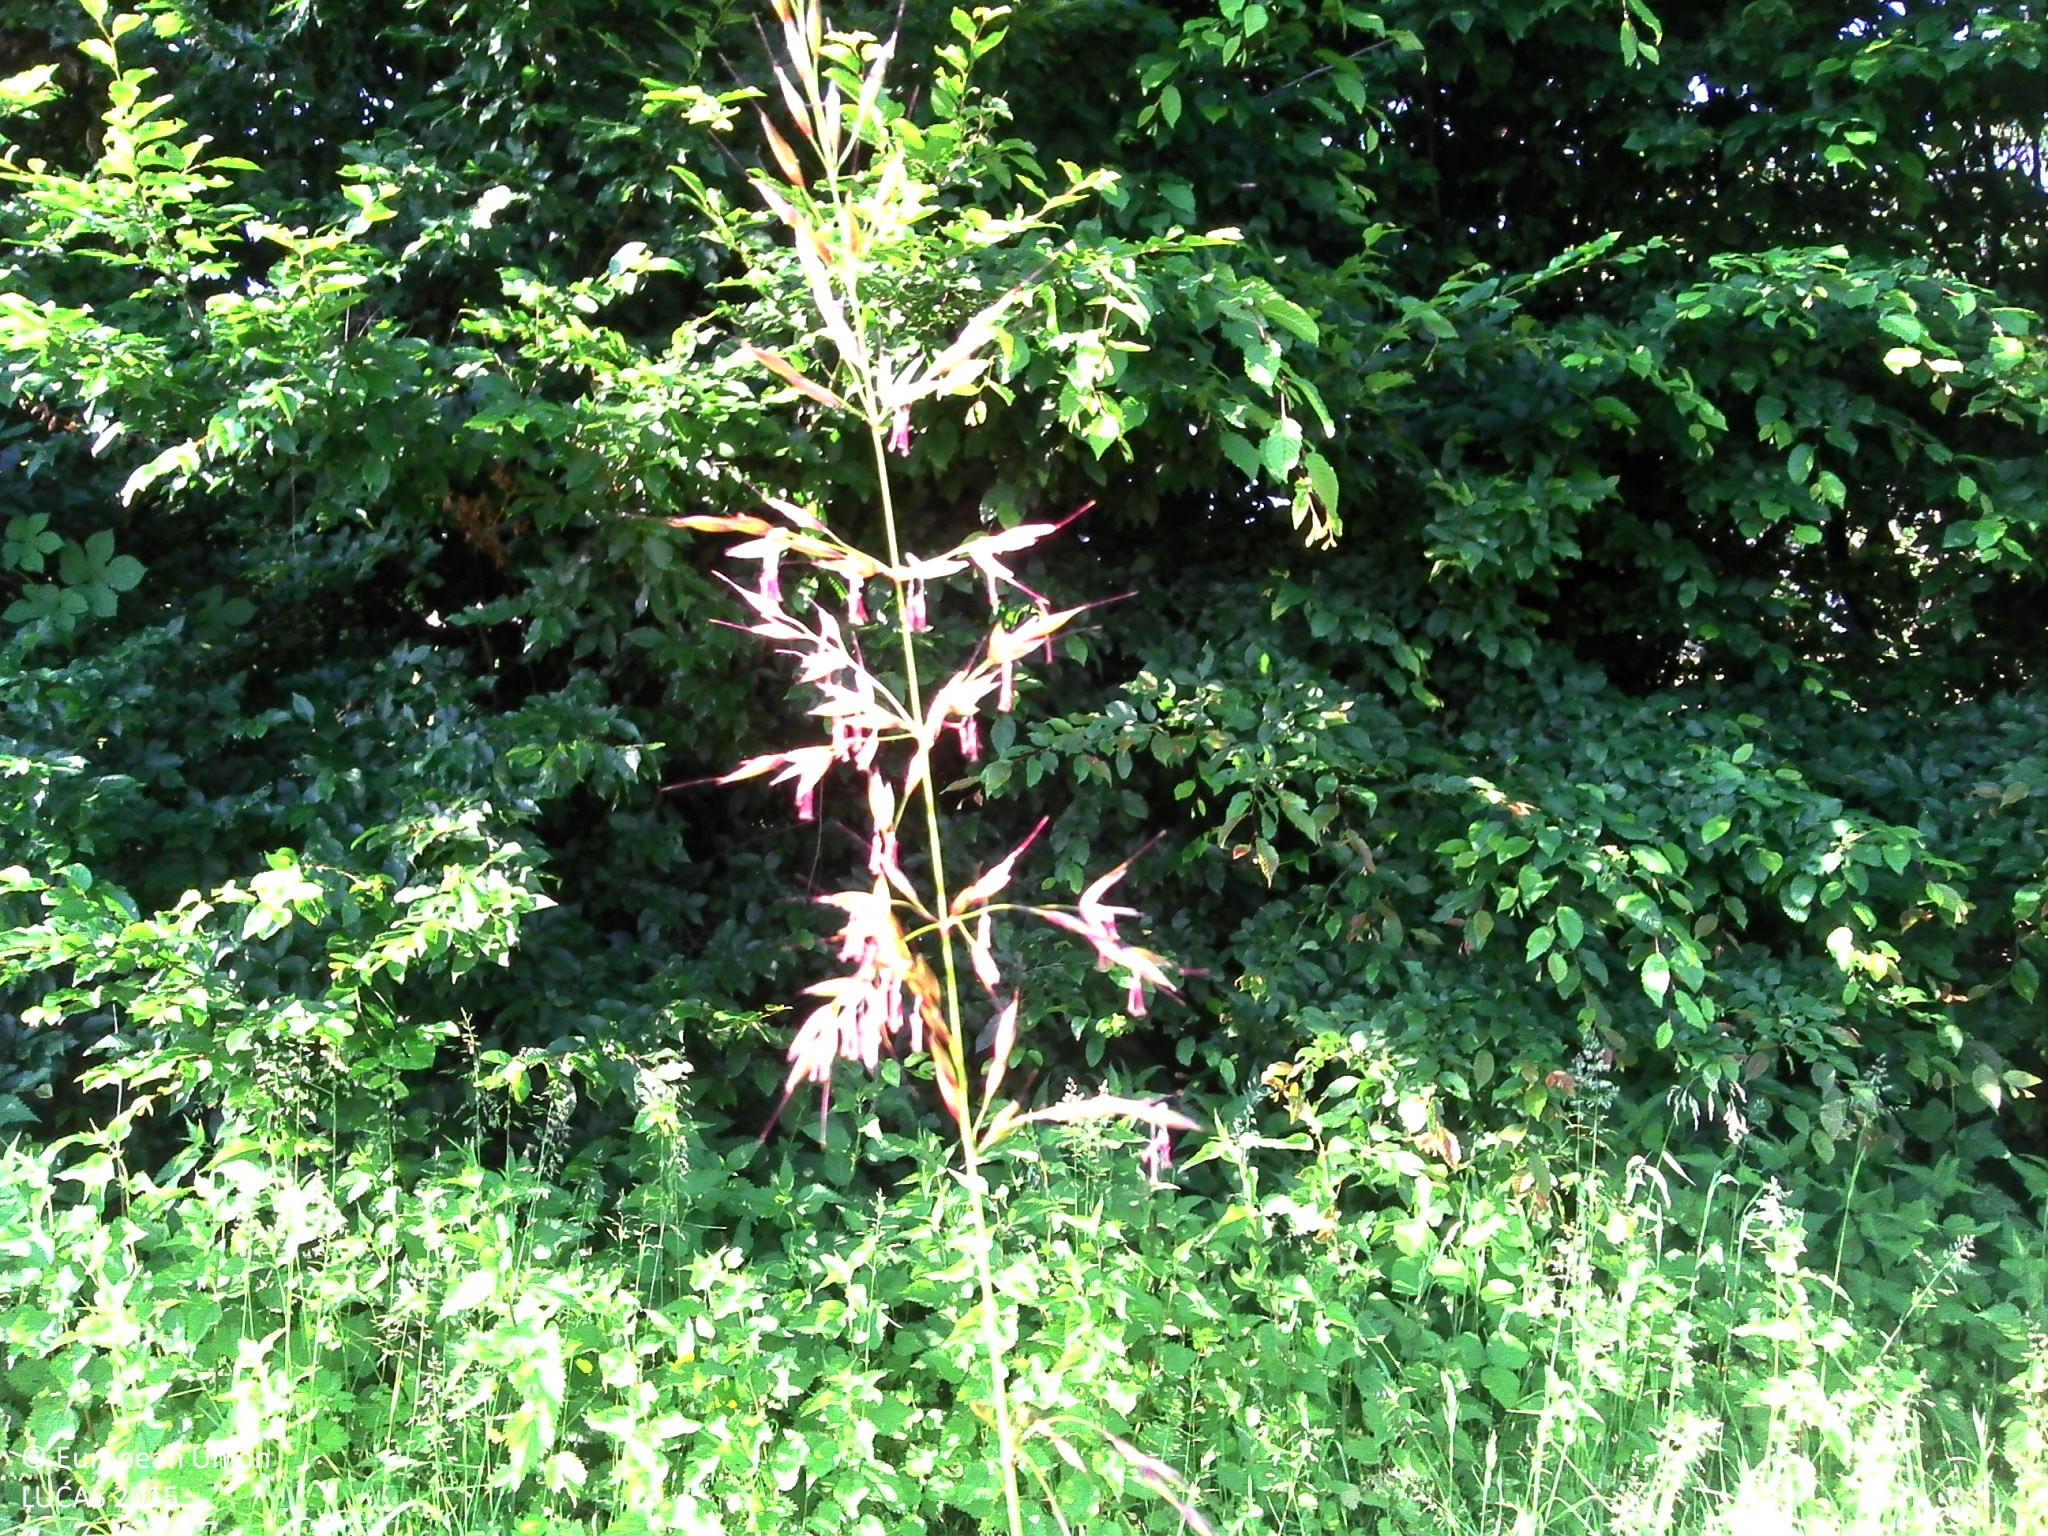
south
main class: Grassland
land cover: Grassland with sparse tree/shrub cover
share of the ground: > 75 %
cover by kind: herbaceous plants 90 %, broadleaved forest trees 5 %, shrubs 5 %
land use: Agriculture (excluding fallow land and kitchen gardens)
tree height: > 5 m
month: June
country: FR
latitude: 48.4560
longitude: 4.6836
